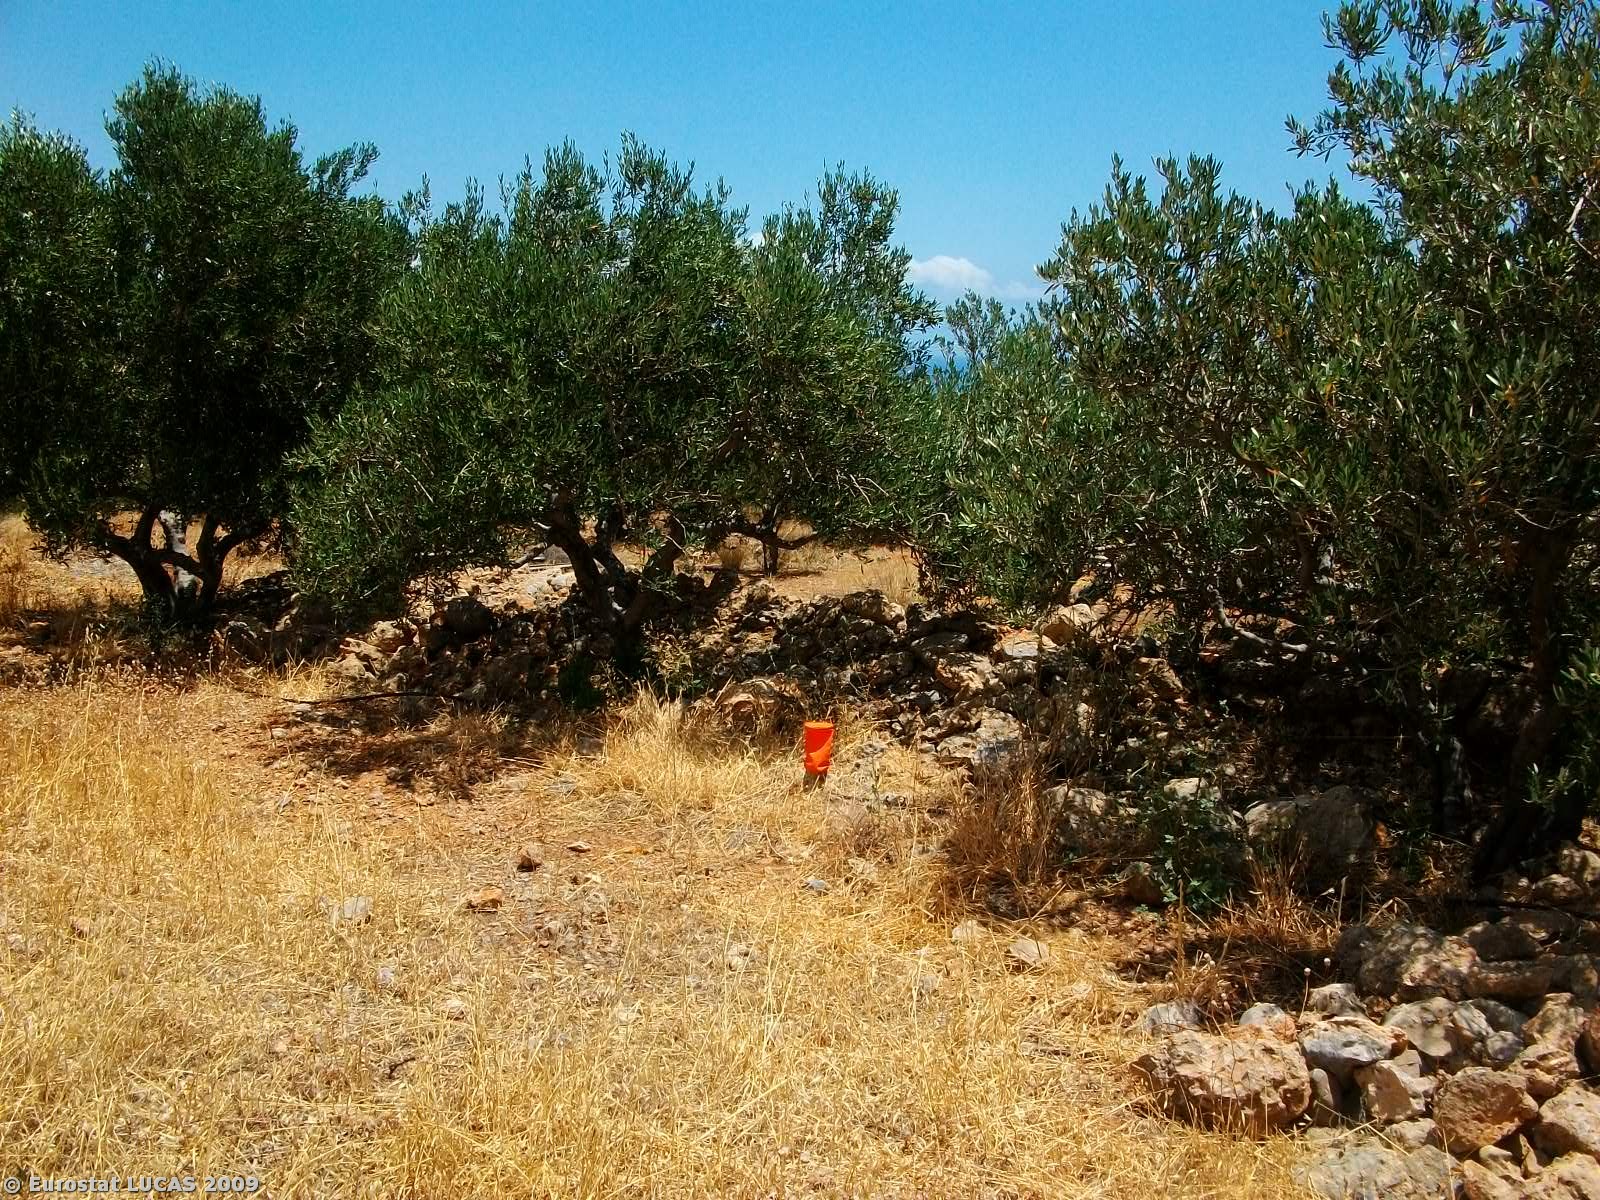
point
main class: Cropland
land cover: Olive groves
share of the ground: 25 - 50 %
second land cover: Bare land
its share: > 75 %
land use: Agriculture (excluding fallow land and kitchen gardens)
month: June
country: GR
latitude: 35.0242
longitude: 25.8544
